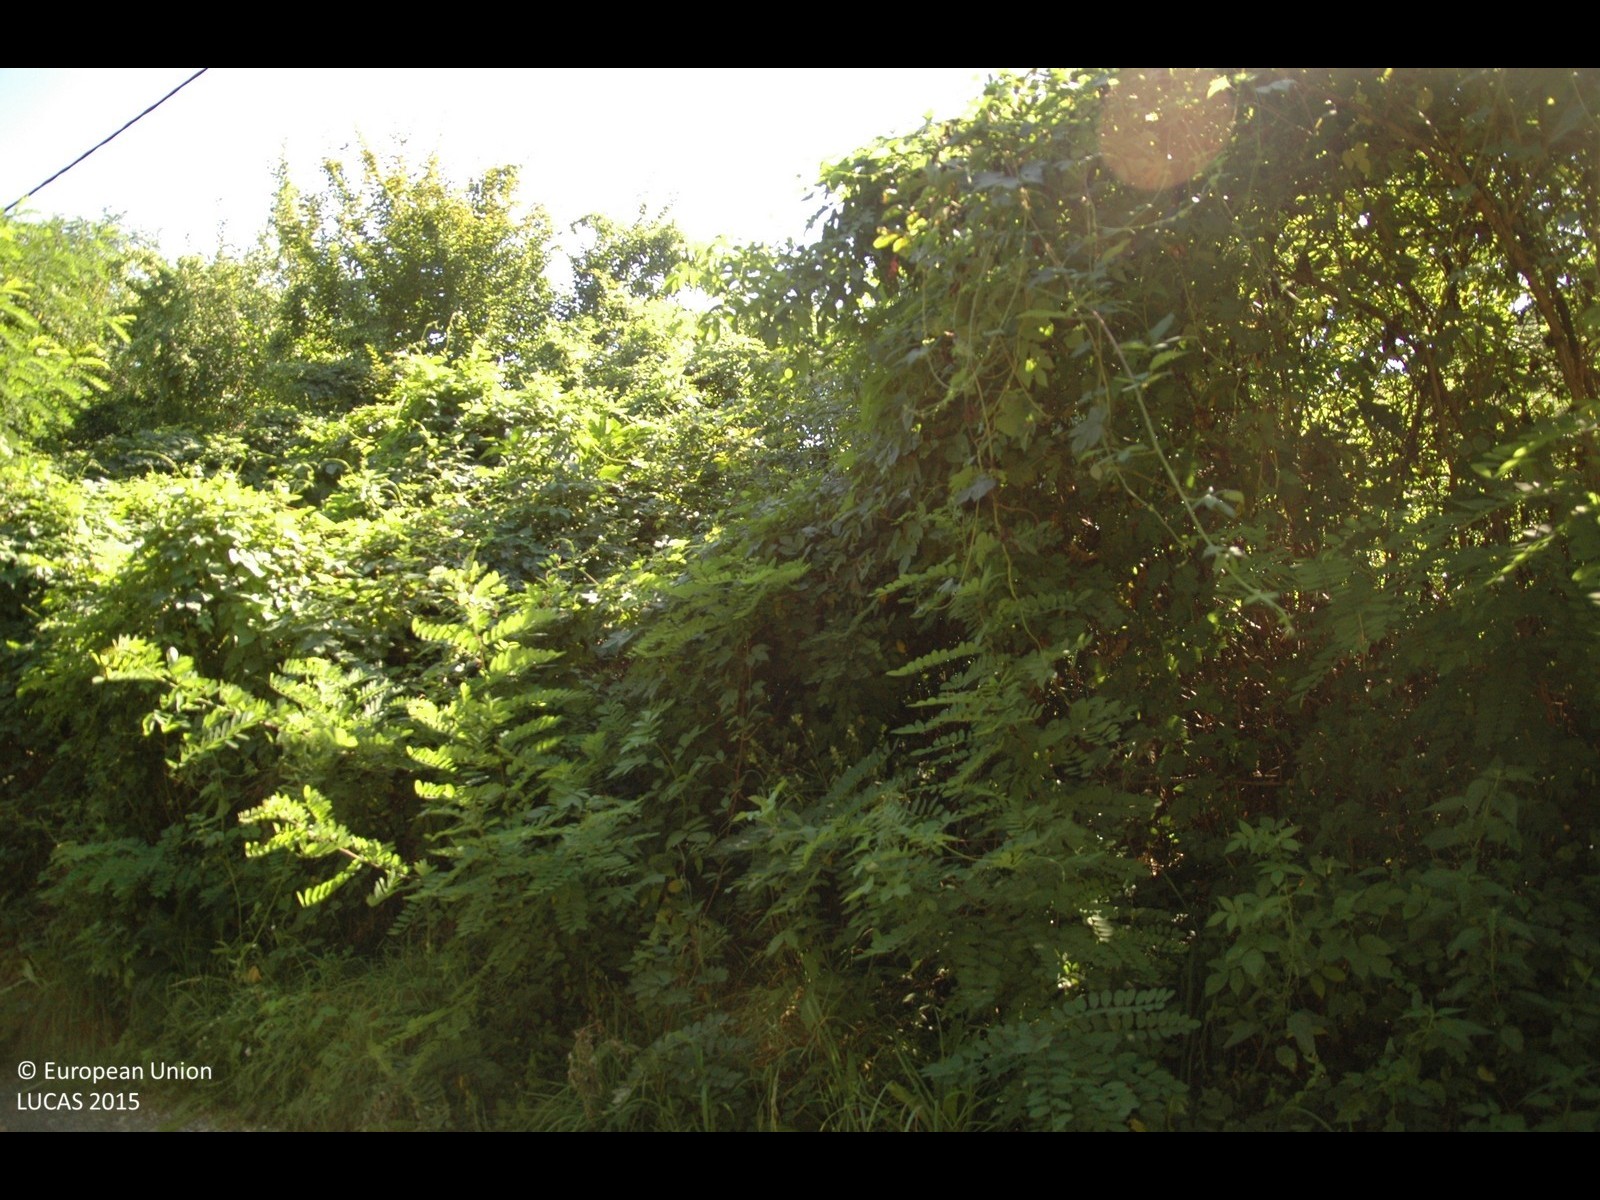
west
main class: Woodland
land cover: Broadleaved woodland
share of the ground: > 75 %
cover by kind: broadleaved forest trees 100 %
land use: Semi-natural and natural areas not in use
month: August
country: HR
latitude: 46.1724
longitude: 16.7753
